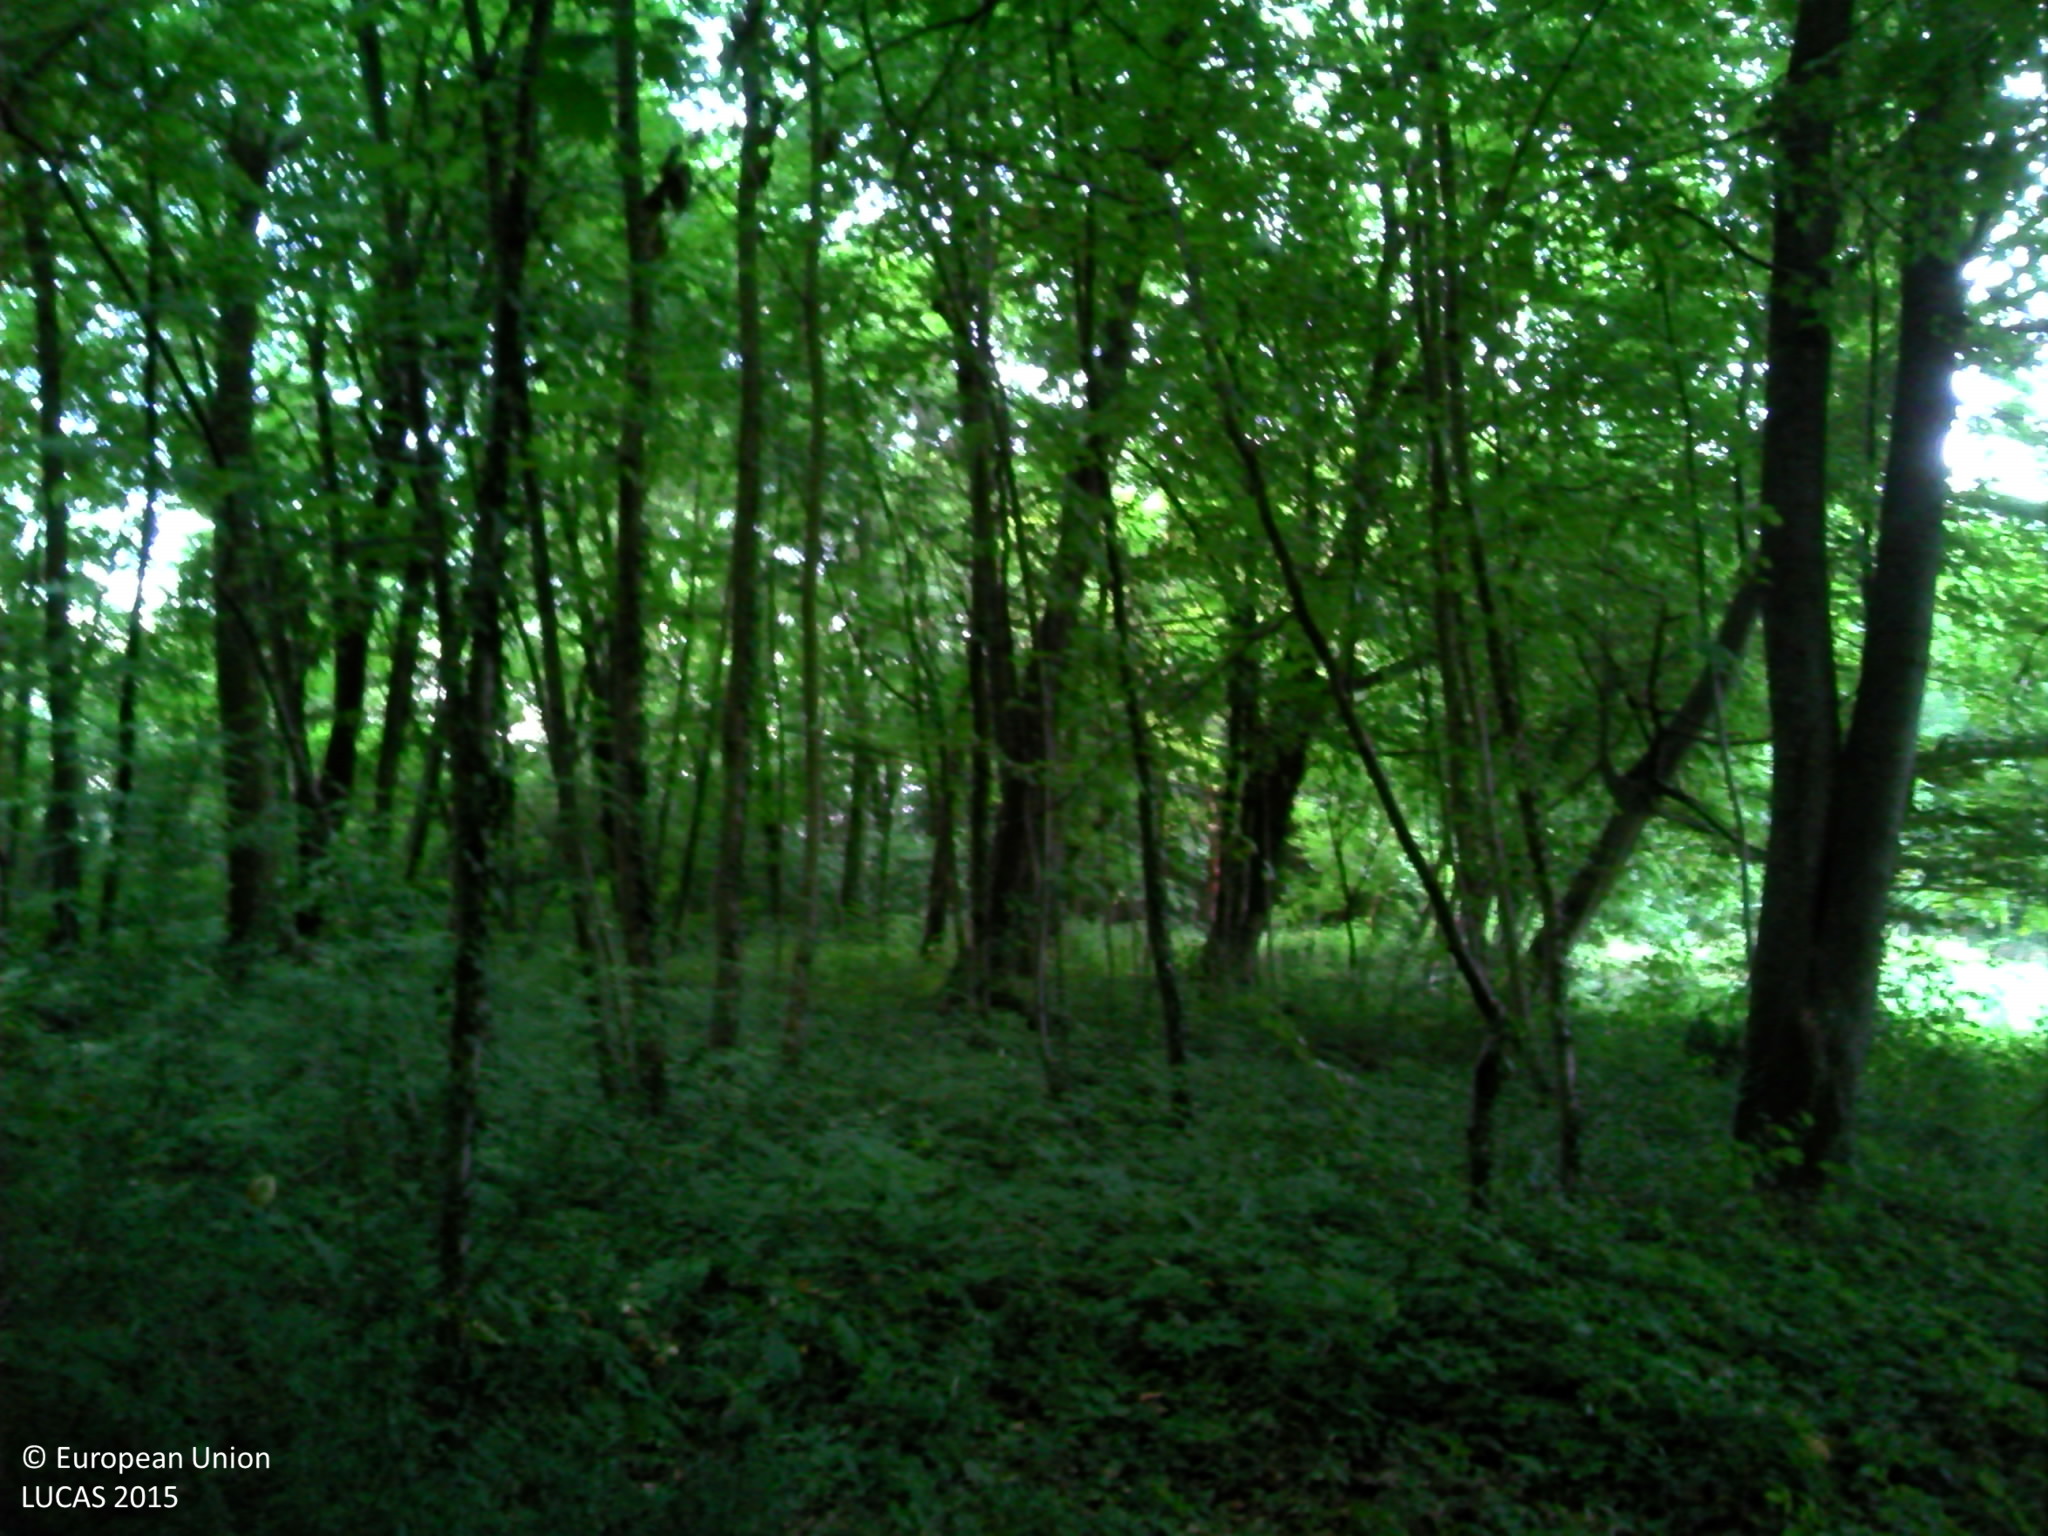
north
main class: Woodland
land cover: Broadleaved woodland
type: mesophytic deciduous forest
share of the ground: > 75 %
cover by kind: broadleaved forest trees 95 %, herbaceous plants 5 %
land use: Forestry
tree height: > 5 m
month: June
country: FR
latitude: 44.7511
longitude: 4.9411
